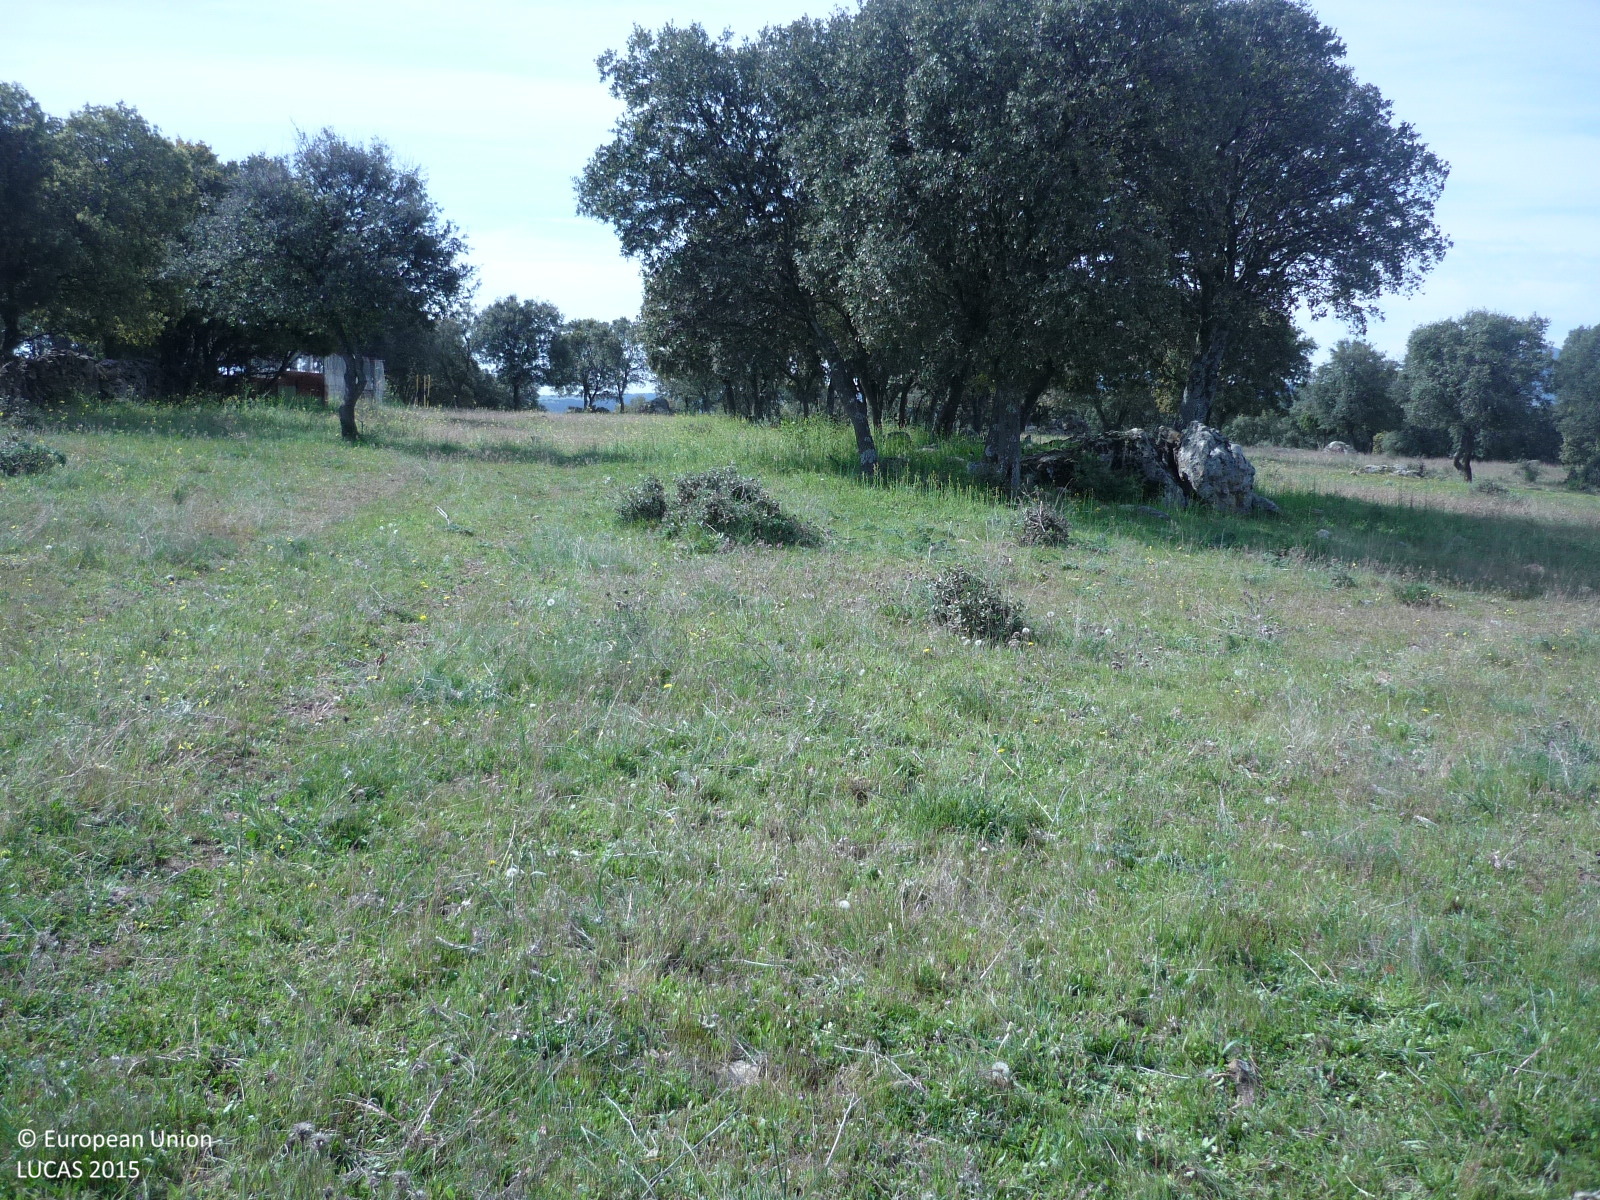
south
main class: Grassland
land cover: Grassland with sparse tree/shrub cover
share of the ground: > 75 %
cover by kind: herbaceous plants 85 %, shrubs 10 %, broadleaved forest trees 5 %
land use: Agriculture (excluding fallow land and kitchen gardens)
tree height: < 5 m
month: April
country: ES
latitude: 40.8294
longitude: -3.6431
